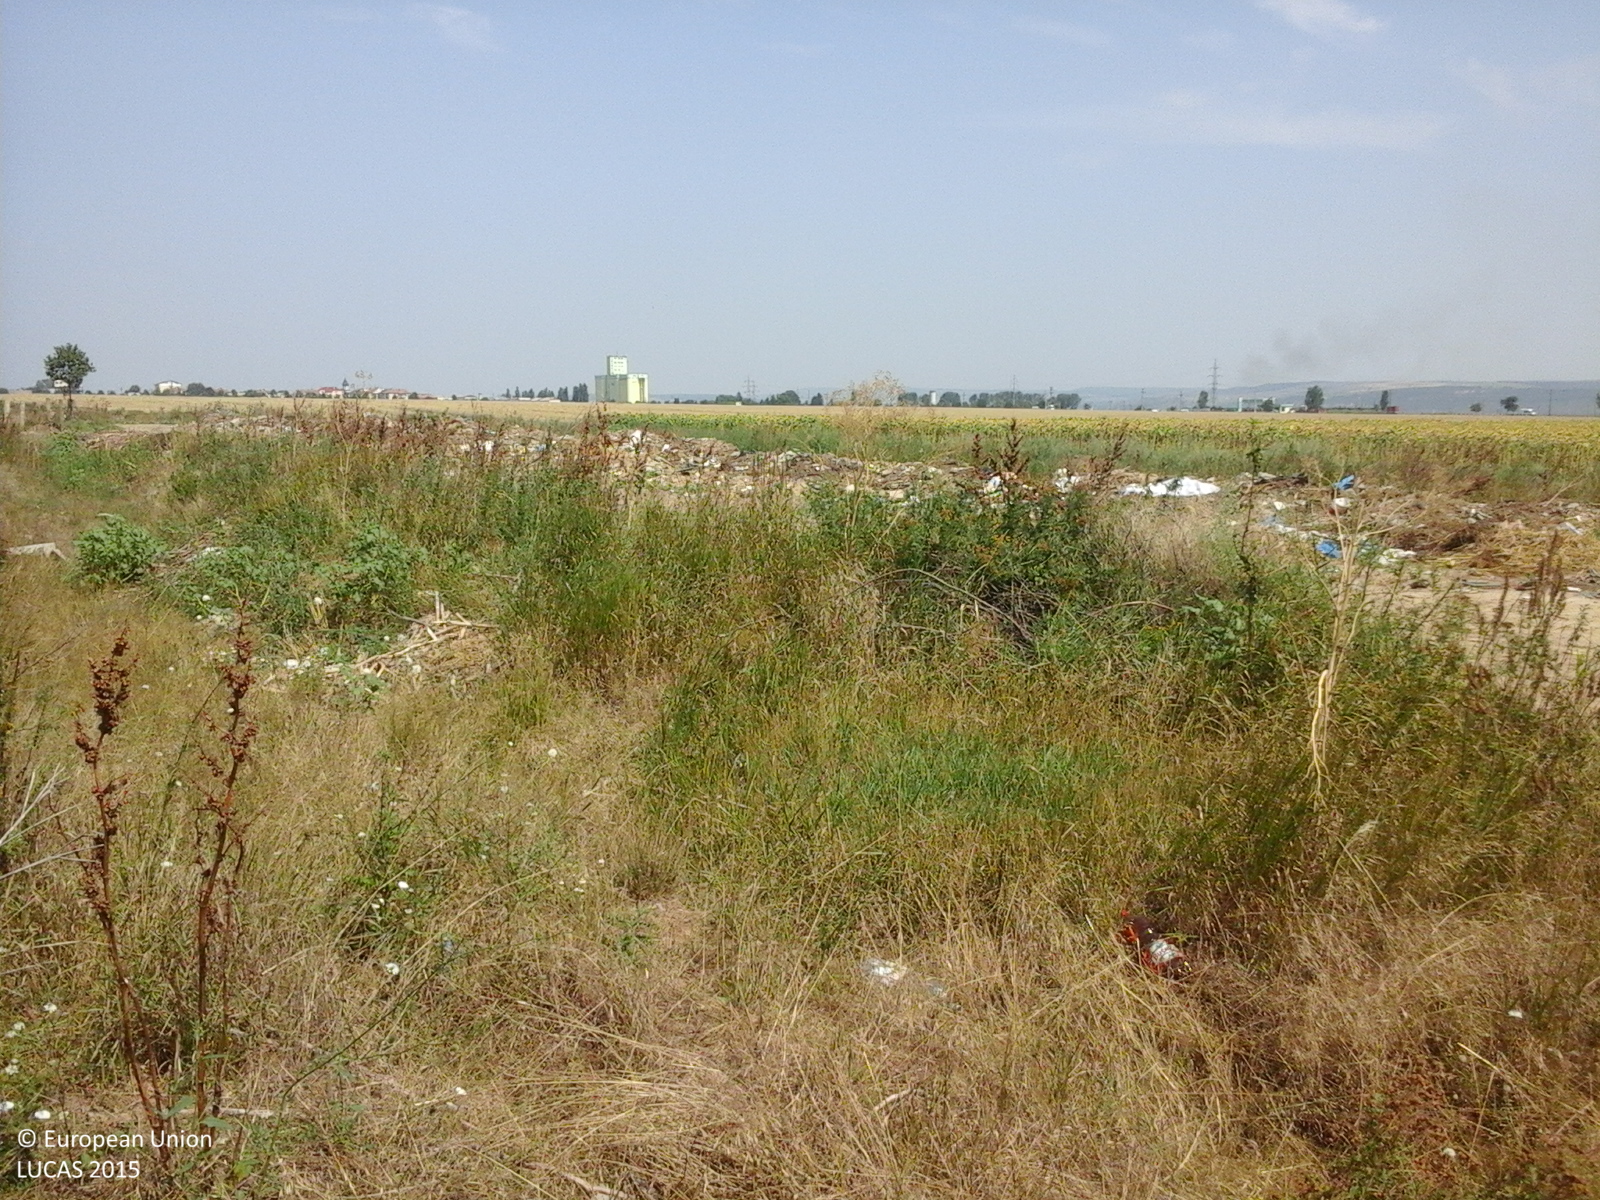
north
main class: Cropland
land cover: Maize
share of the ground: > 75 %
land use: Agriculture (excluding fallow land and kitchen gardens)
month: August
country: RO
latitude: 46.1919
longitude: 27.1096
